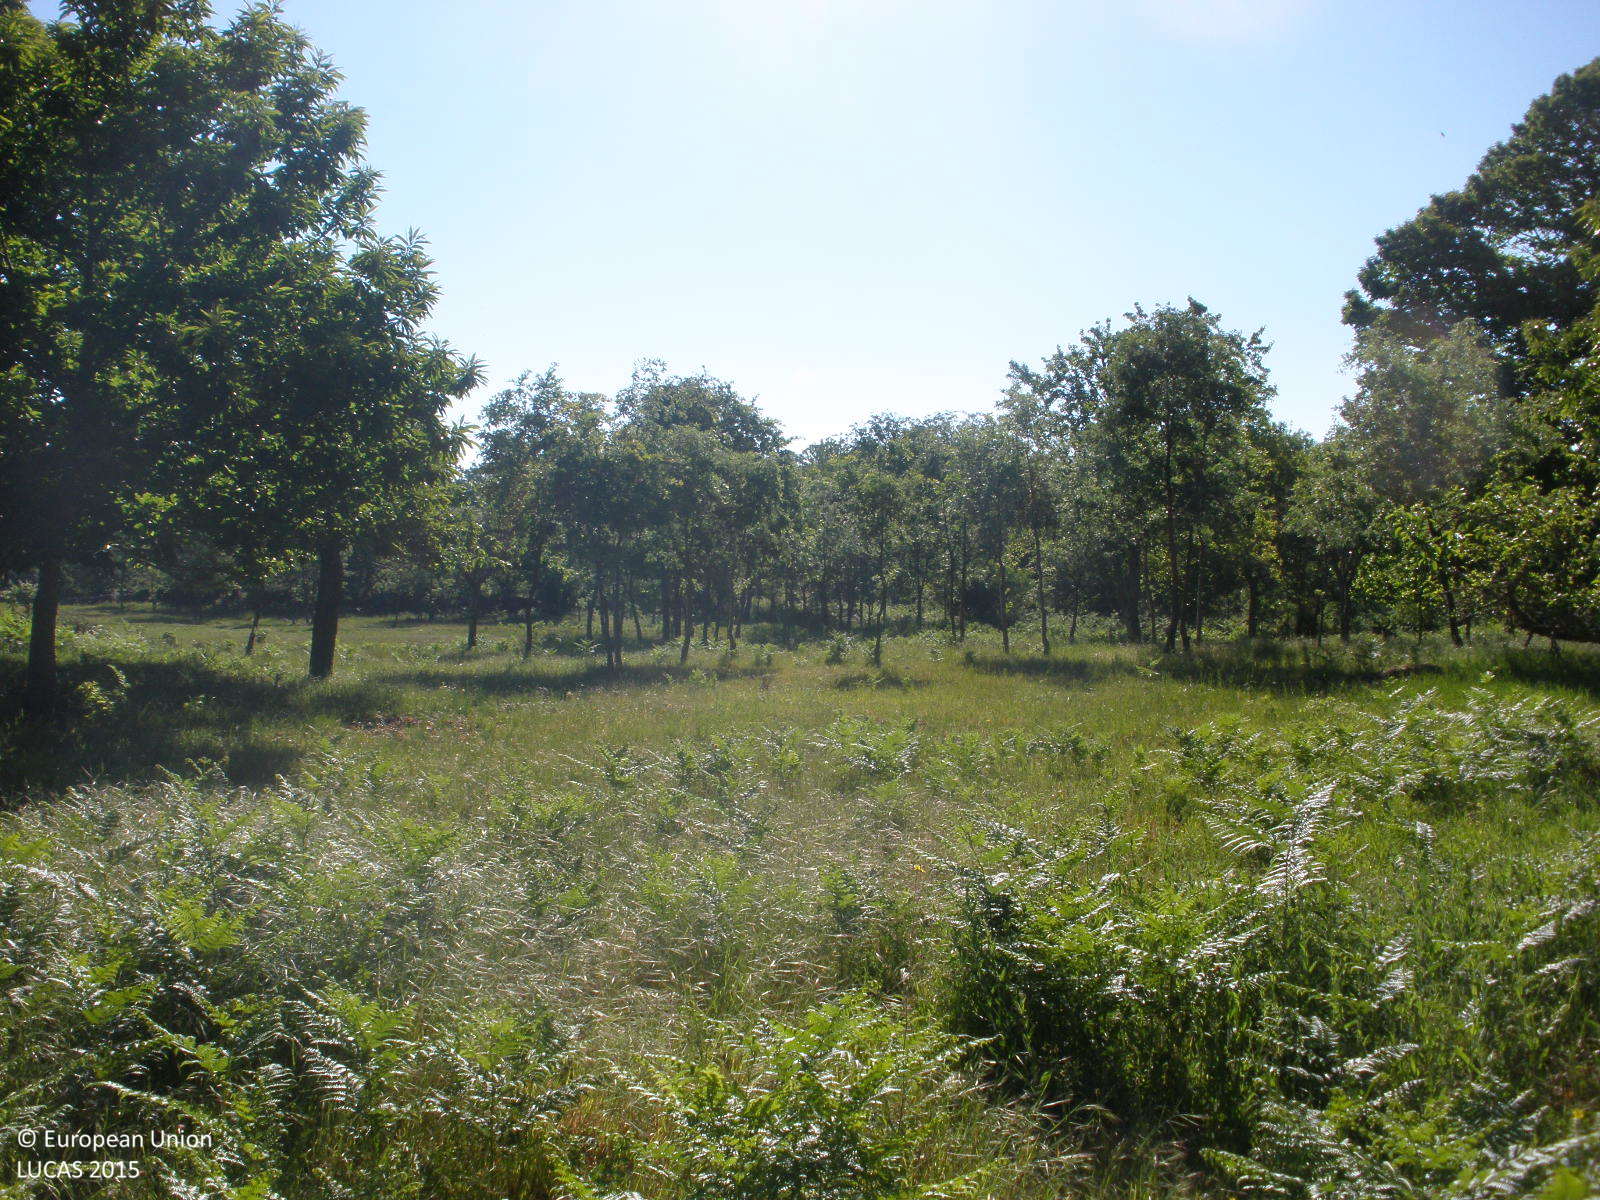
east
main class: Grassland
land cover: Grassland with sparse tree/shrub cover
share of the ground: > 75 %
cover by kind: herbaceous plants 95 %, broadleaved forest trees 5 %
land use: Agriculture (excluding fallow land and kitchen gardens)
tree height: > 5 m
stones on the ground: < 10 %
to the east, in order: Grassland with sparse tree/shrub cover; Broadleaved woodland; Grassland with sparse tree/shrub cover; Dry stone walls; Grassland without tree/shrub cover; Dry stone walls; Grassland with sparse tree/shrub cover; Dry stone walls; Broadleaved woodland; Dry stone walls; Paved roads, cycling and walking lanes; Broadleaved woodland
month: May
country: ES
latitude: 40.5213
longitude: -6.1449
